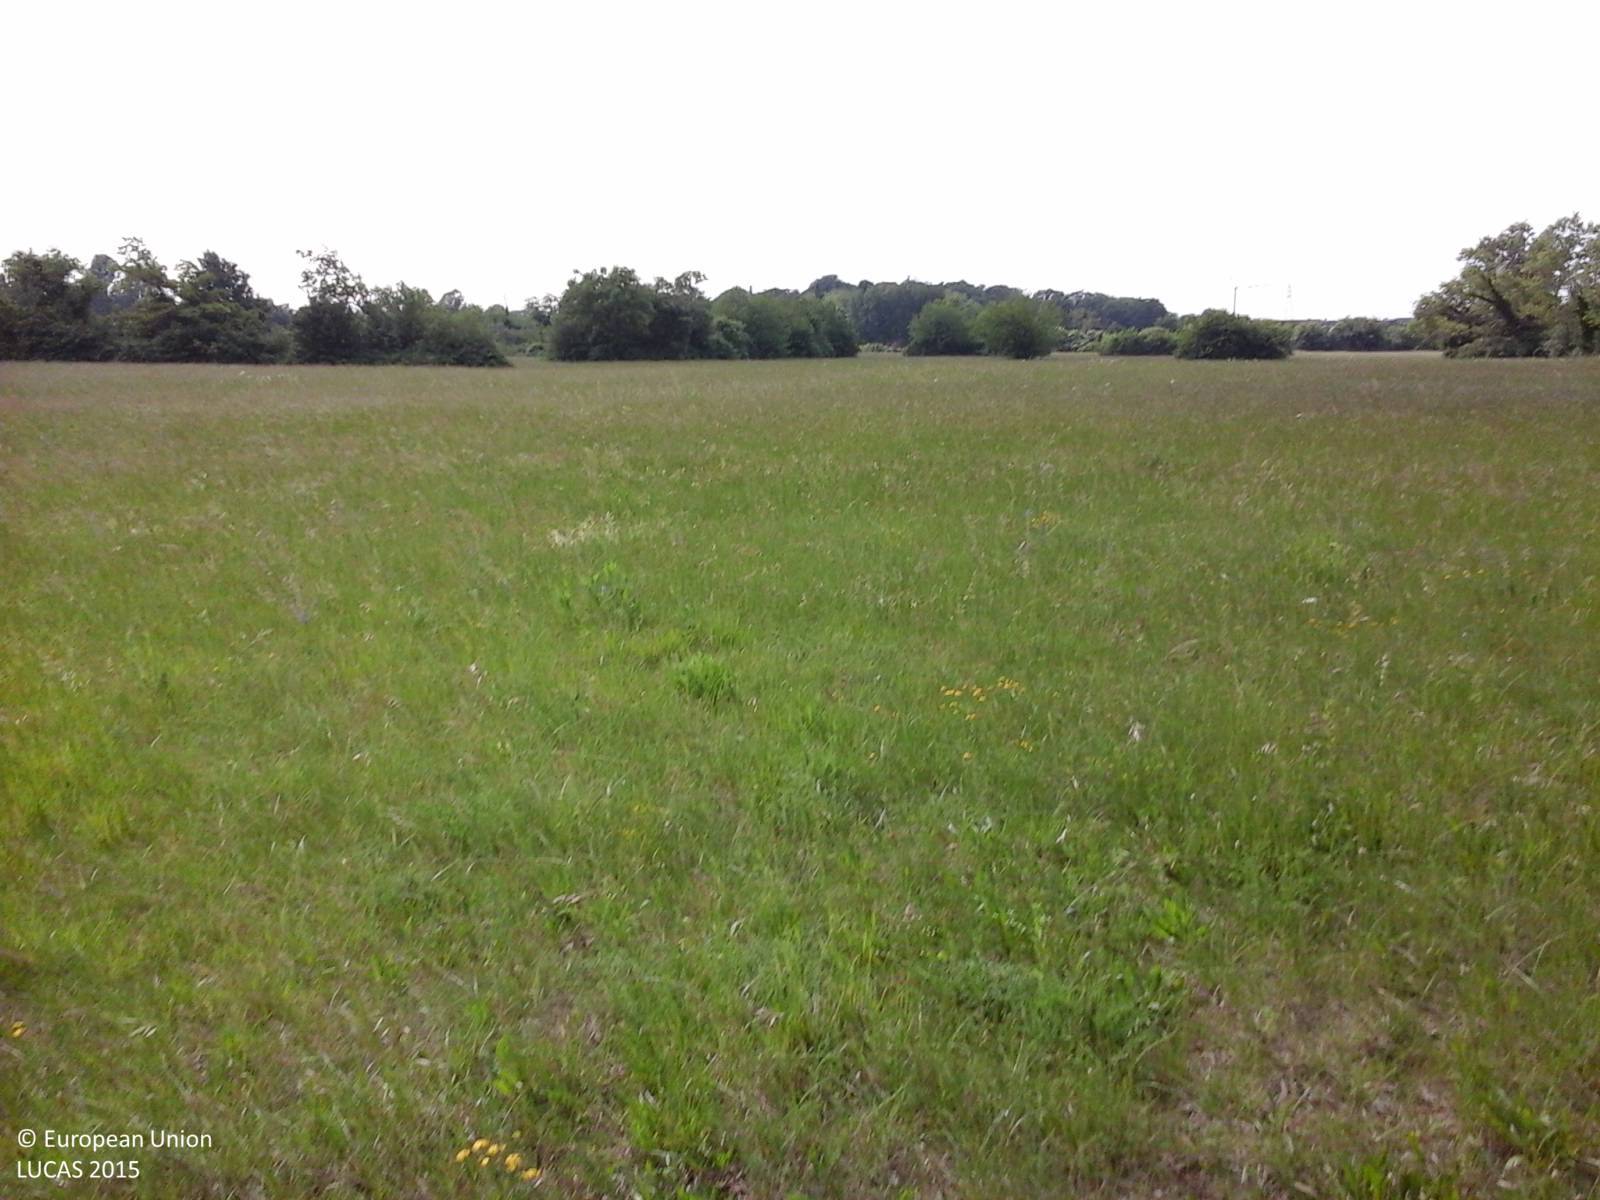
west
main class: Grassland
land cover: Grassland without tree/shrub cover
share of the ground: > 75 %
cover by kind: herbaceous plants 100 %
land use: Agriculture (excluding fallow land and kitchen gardens)
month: May
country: IT
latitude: 46.0474
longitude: 13.3177
